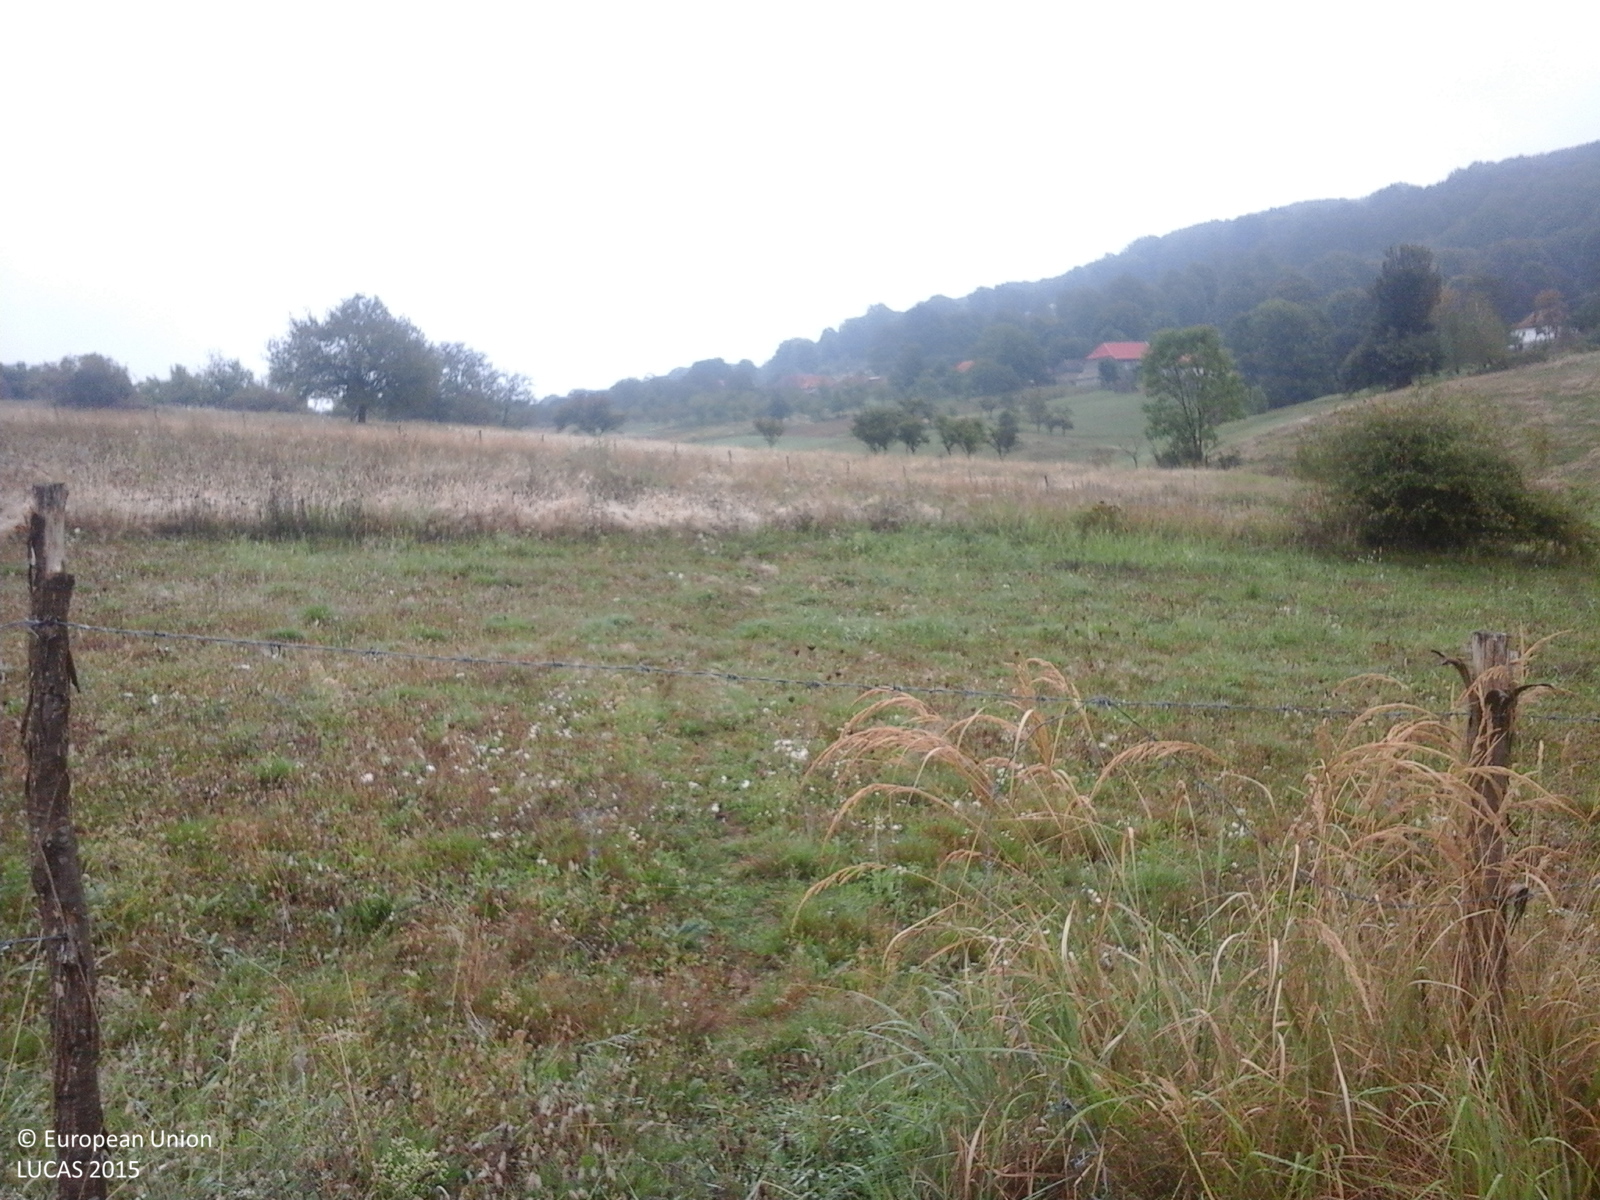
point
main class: Grassland
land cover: Grassland without tree/shrub cover
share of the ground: > 75 %
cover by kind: herbaceous plants 100 %
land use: Agriculture (excluding fallow land and kitchen gardens)
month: September
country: RO
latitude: 46.9124
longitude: 22.4608
